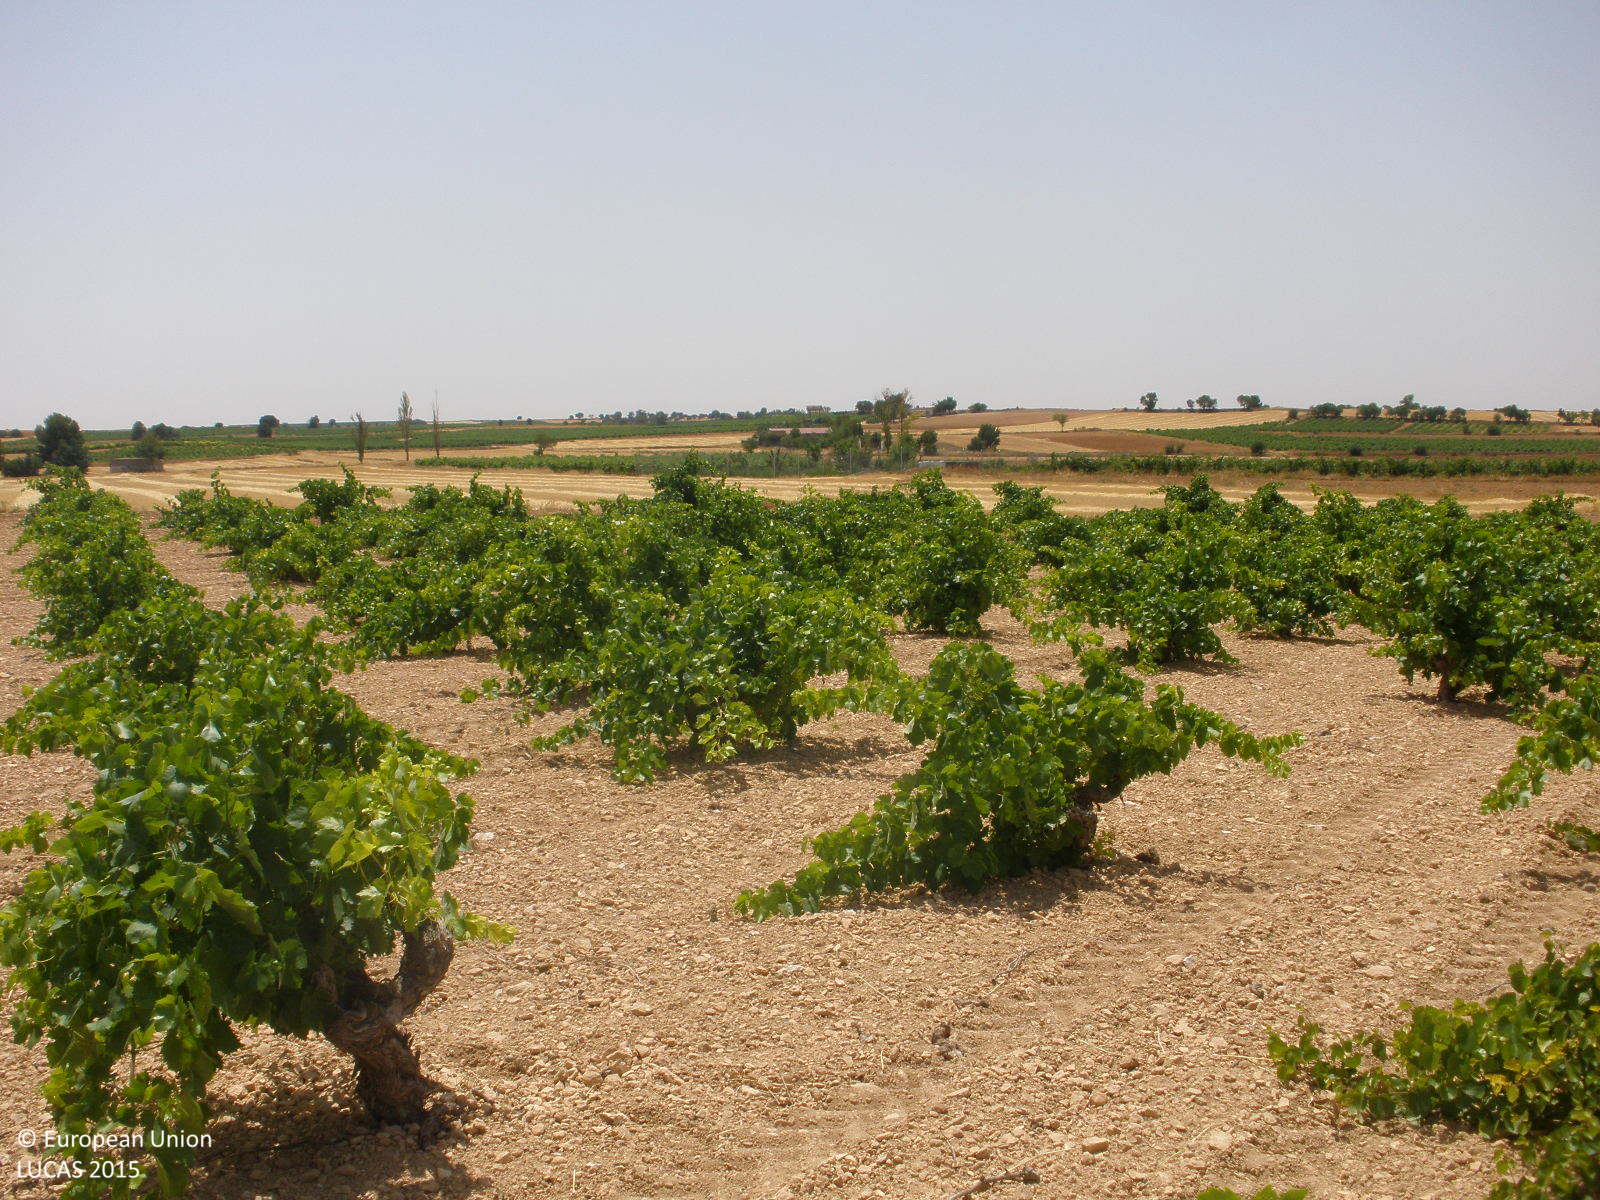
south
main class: Cropland
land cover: Vineyards
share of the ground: 50 - 75 %
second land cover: Other bare soil
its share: > 75 %
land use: Agriculture (excluding fallow land and kitchen gardens)
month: July
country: ES
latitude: 39.9640
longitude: -3.1485
